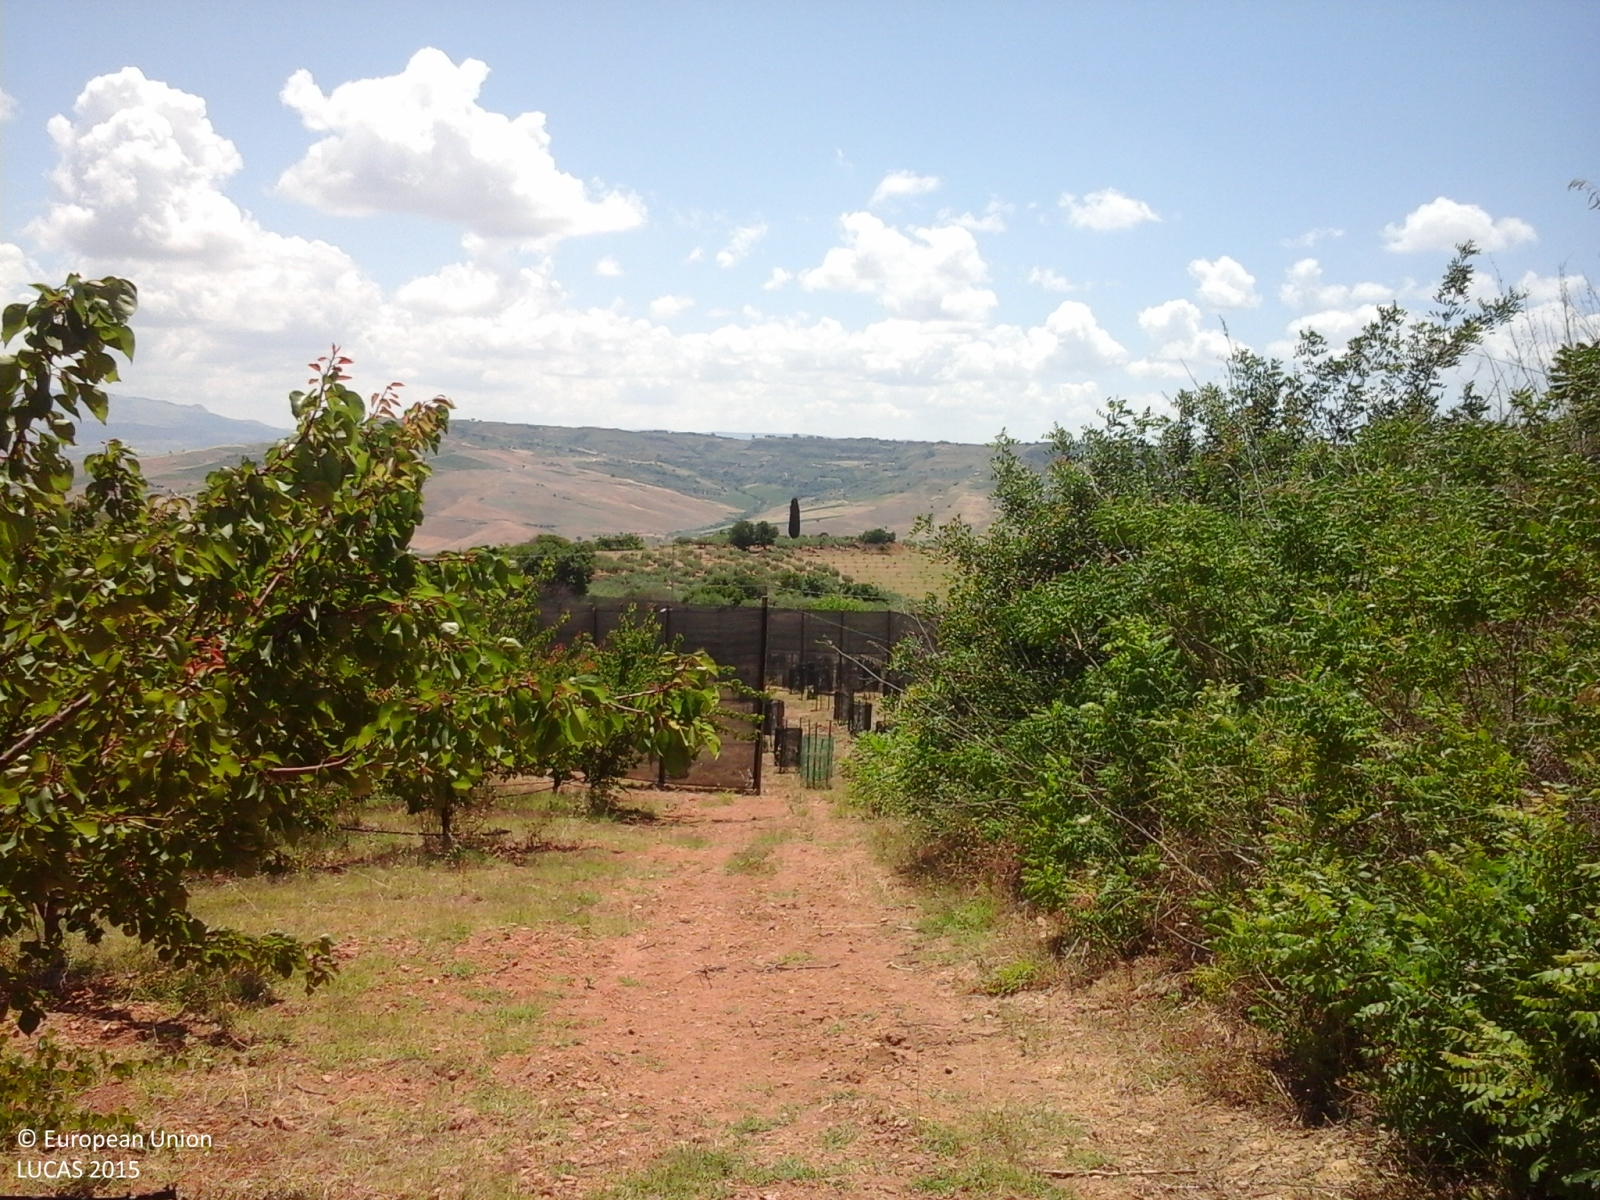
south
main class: Cropland
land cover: Other fruit trees and berries
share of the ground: 25 - 50 %
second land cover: Spontaneously vegetated surfaces
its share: 50 - 75 %
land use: Agriculture (excluding fallow land and kitchen gardens)
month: June
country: IT
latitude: 37.7385
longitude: 12.9398
